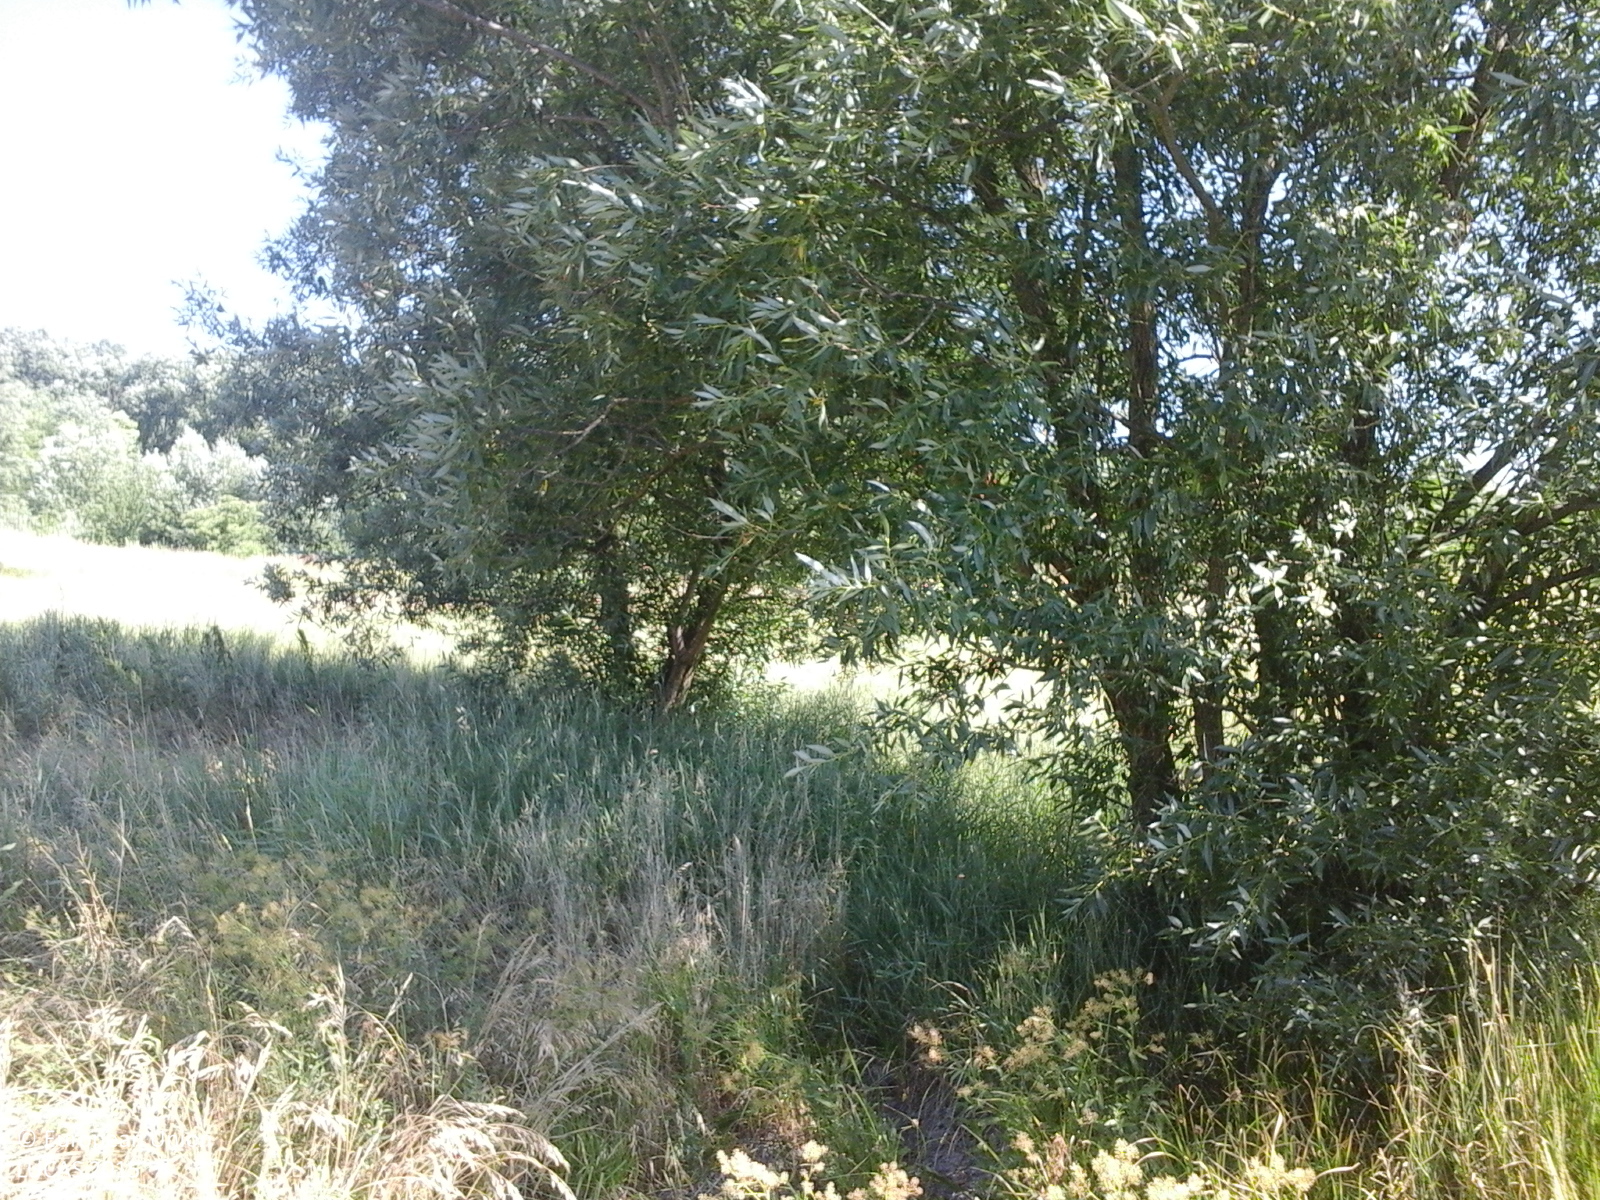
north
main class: Grassland
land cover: Grassland without tree/shrub cover
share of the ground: > 75 %
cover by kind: herbaceous plants 100 %
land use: Agriculture (excluding fallow land and kitchen gardens)
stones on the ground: < 10 %
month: June
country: RO
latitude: 47.7820
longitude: 26.8232
